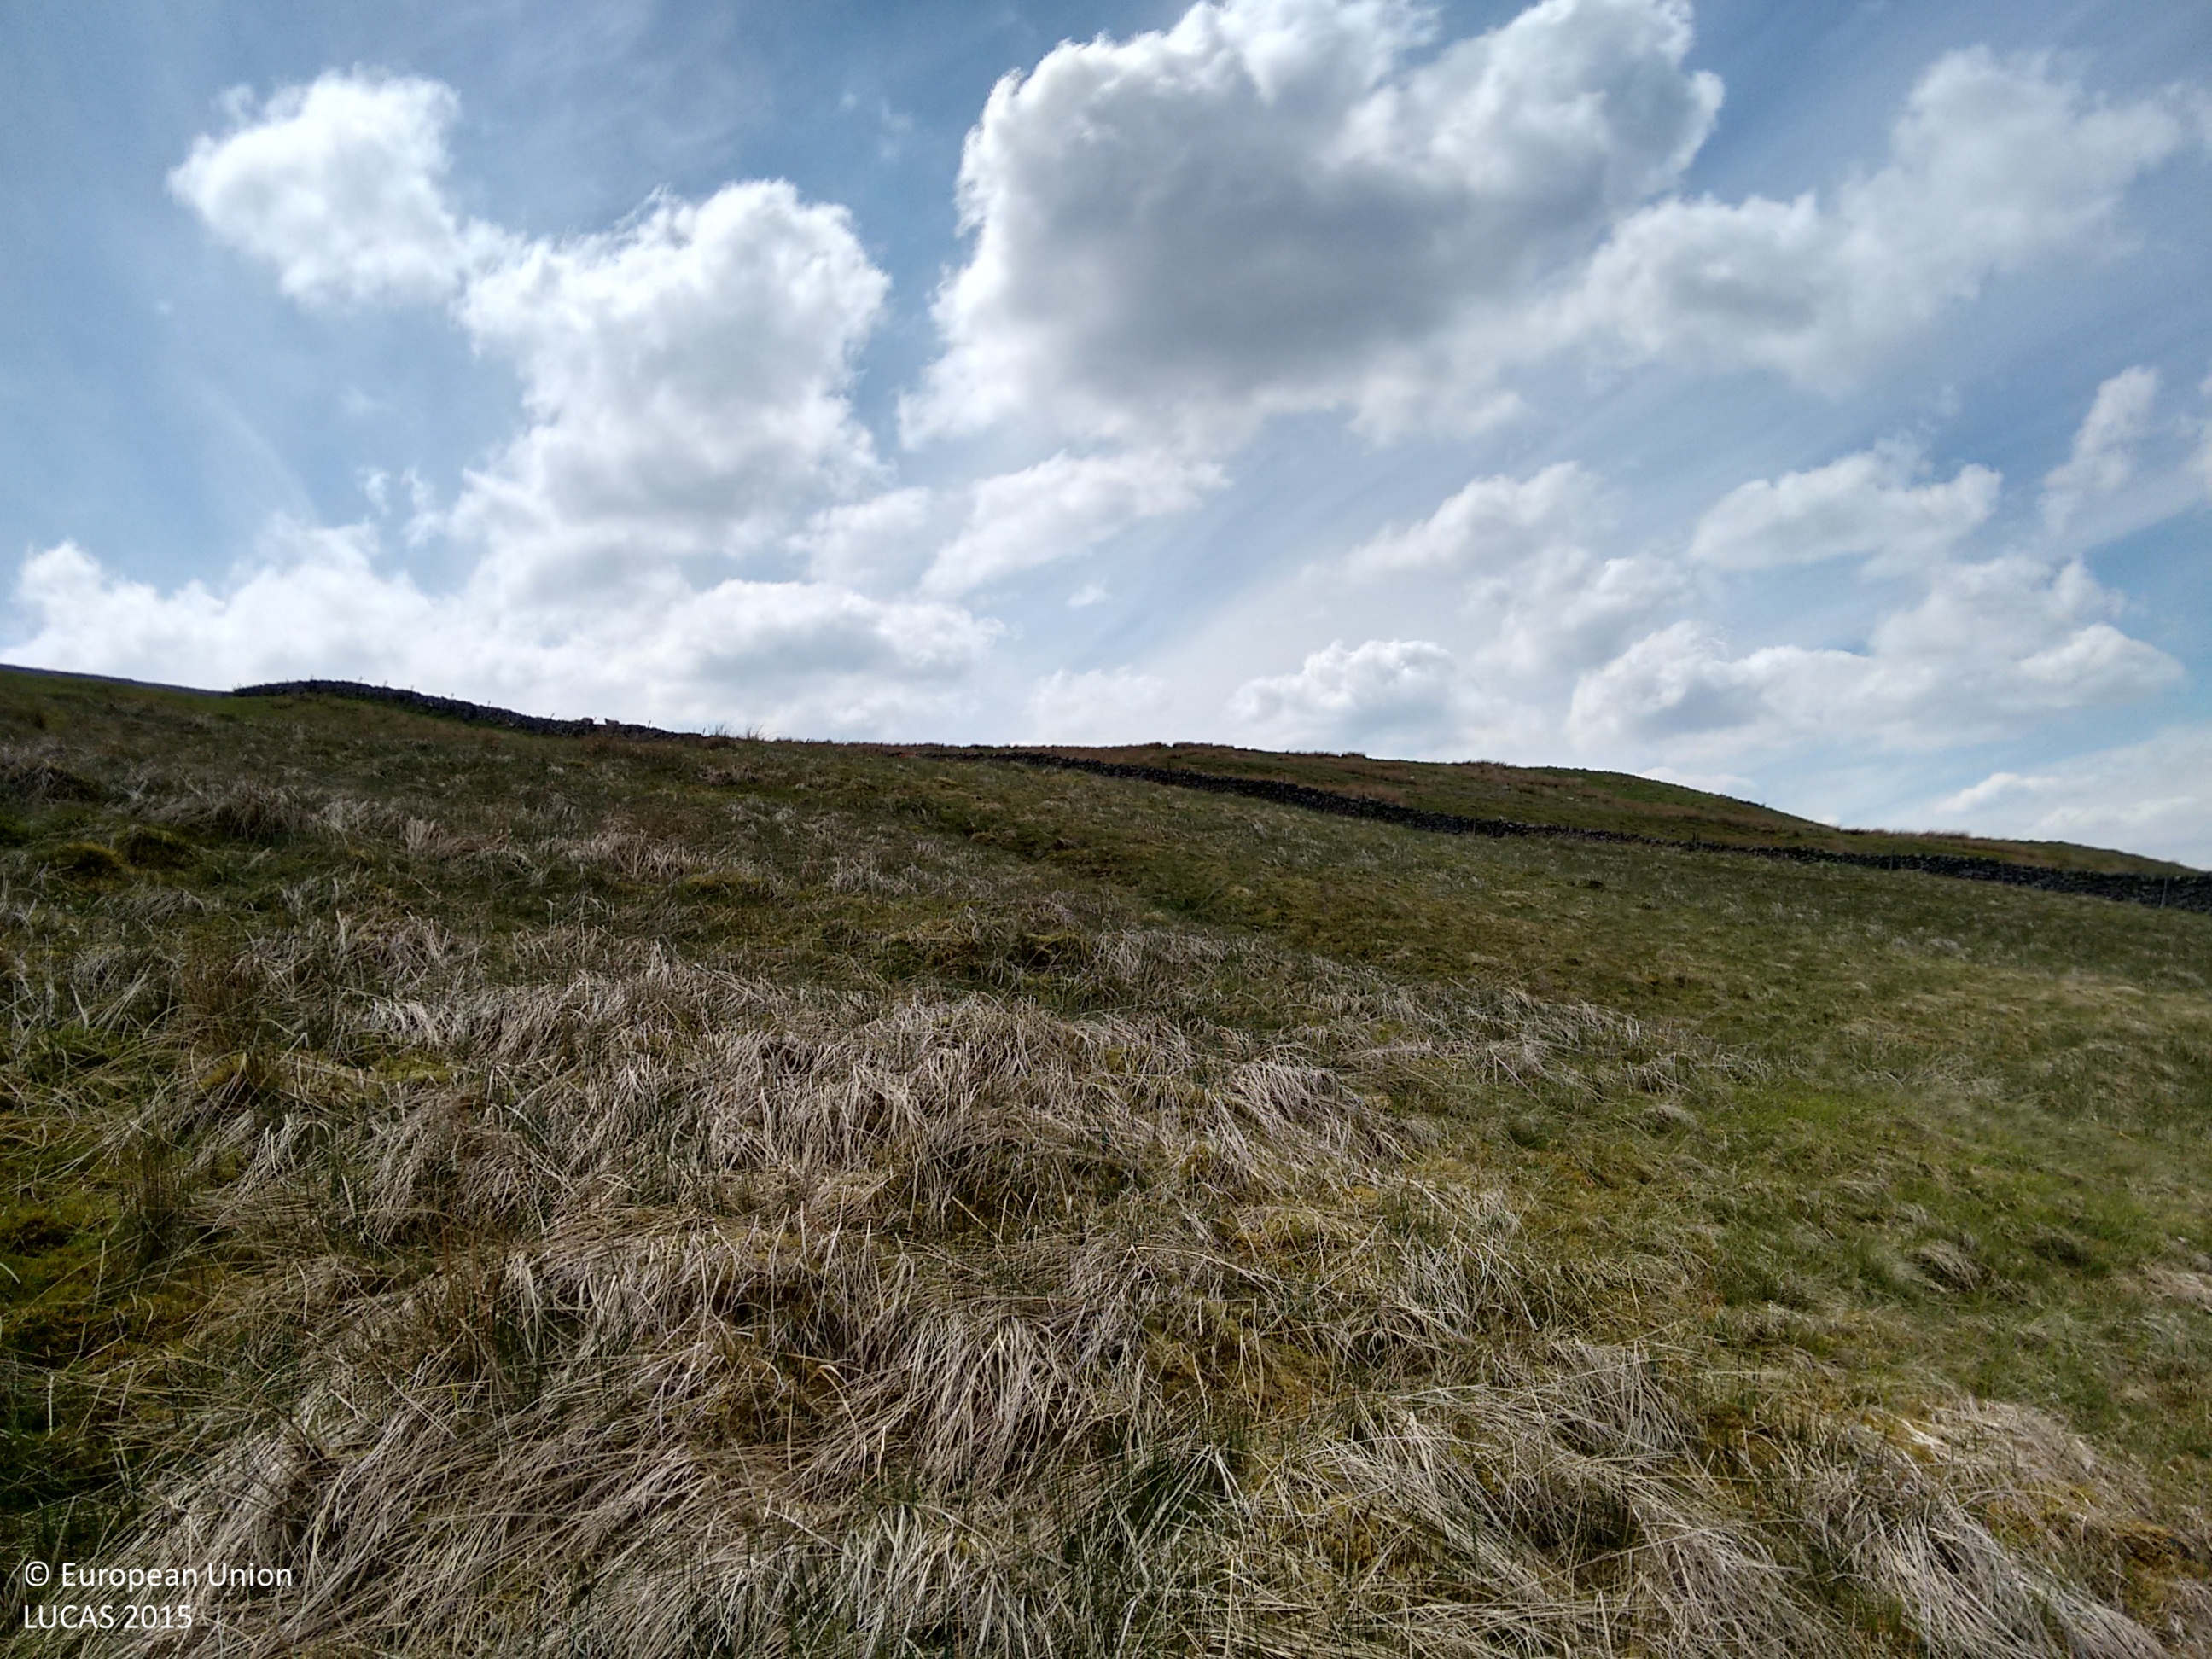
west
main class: Grassland
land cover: Grassland without tree/shrub cover
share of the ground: > 75 %
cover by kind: herbaceous plants 100 %
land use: Agriculture (excluding fallow land and kitchen gardens)
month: June
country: GB
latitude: 54.1822
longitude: -2.2106
